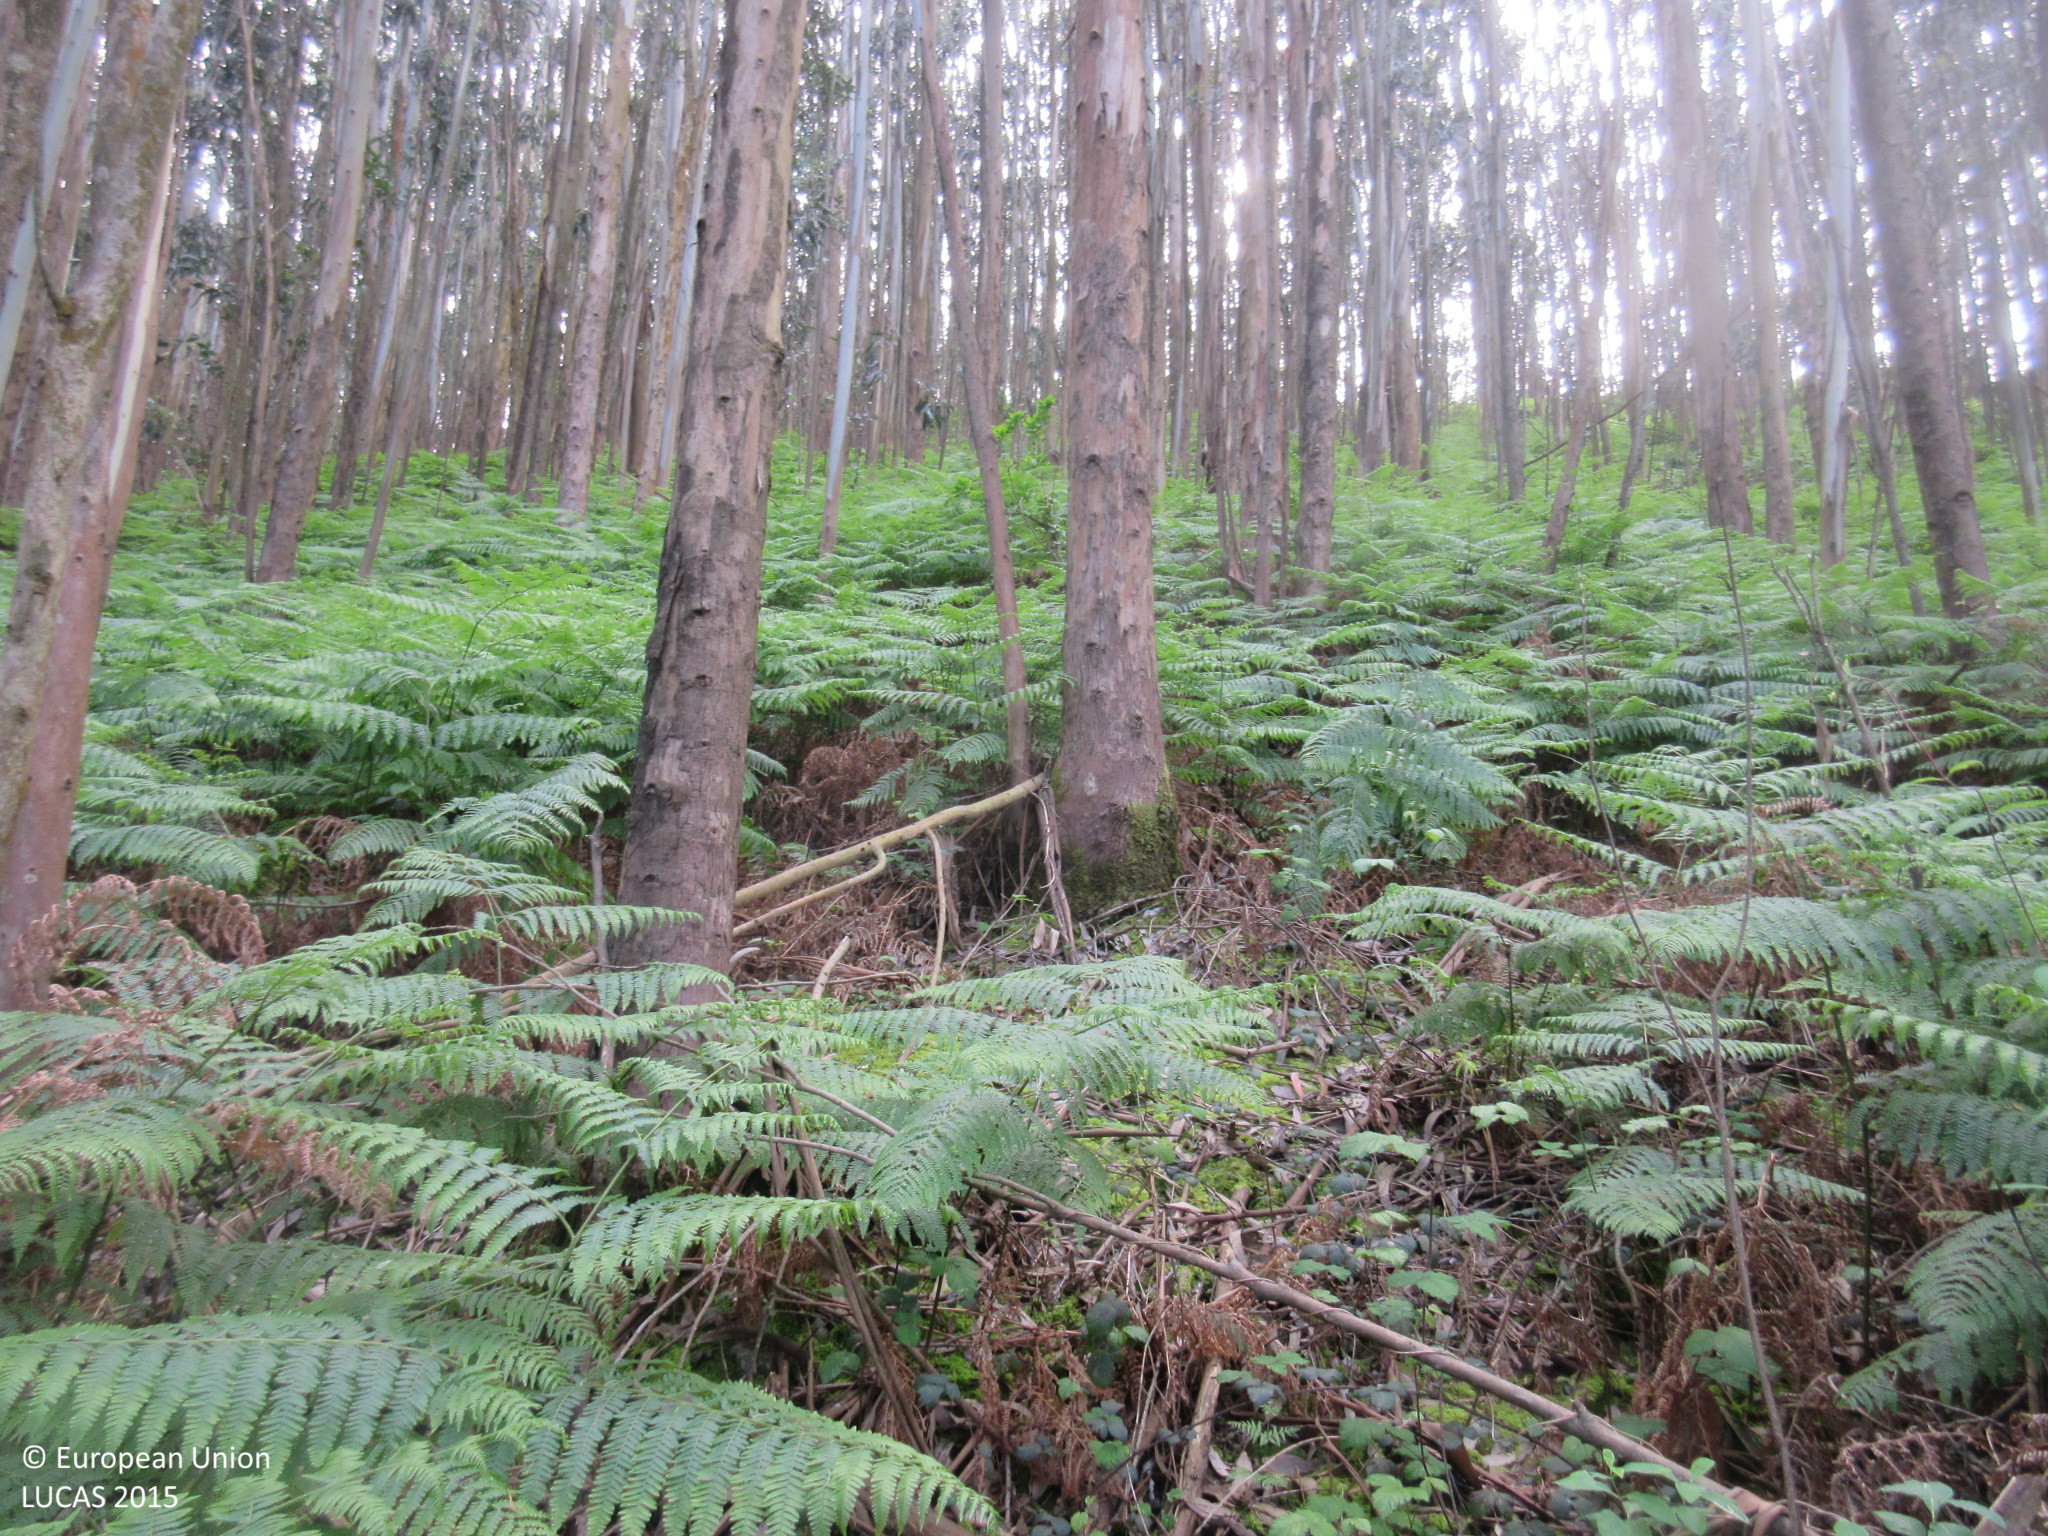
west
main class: Woodland
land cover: Broadleaved woodland
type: exotic forest
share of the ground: > 75 %
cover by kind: broadleaved forest trees 100 %
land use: Forestry
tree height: > 5 m
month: May
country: ES
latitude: 43.5681
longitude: -6.0543
